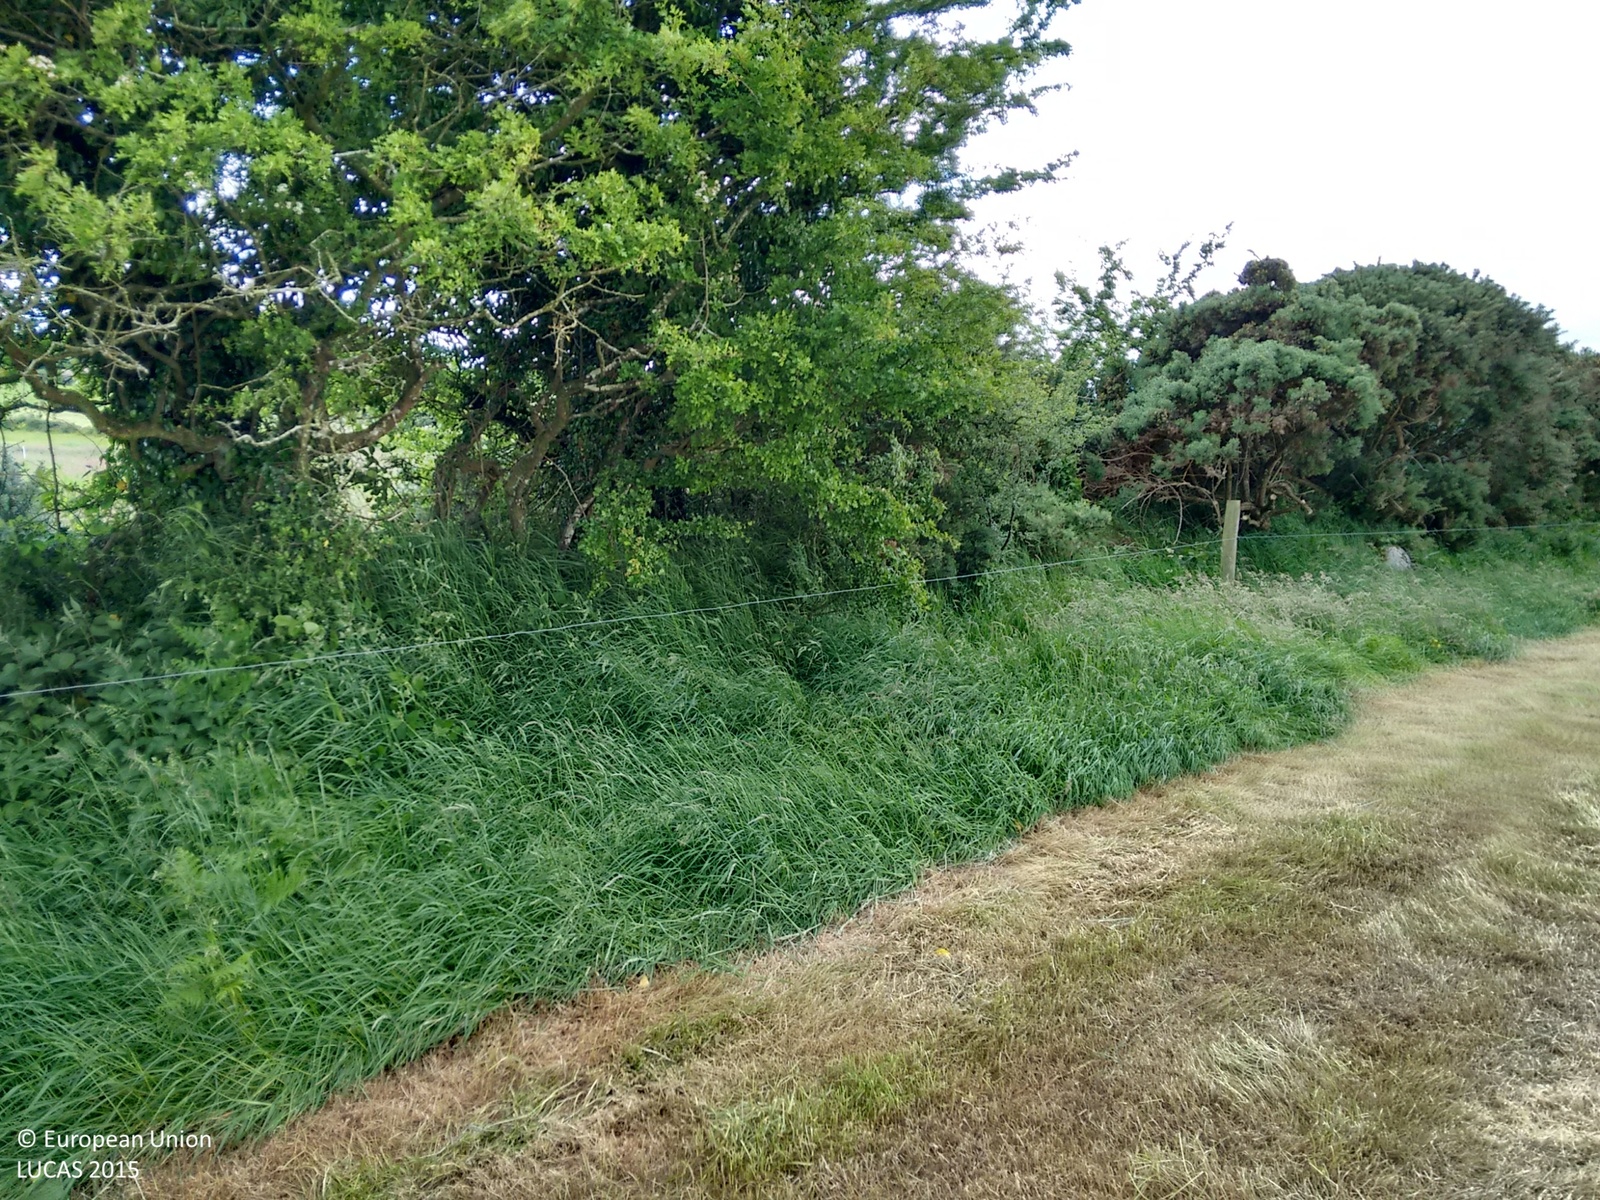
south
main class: Grassland
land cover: Grassland without tree/shrub cover
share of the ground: > 75 %
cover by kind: herbaceous plants 100 %
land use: Agriculture (excluding fallow land and kitchen gardens)
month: June
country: IE
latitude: 52.2088
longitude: -7.3493
